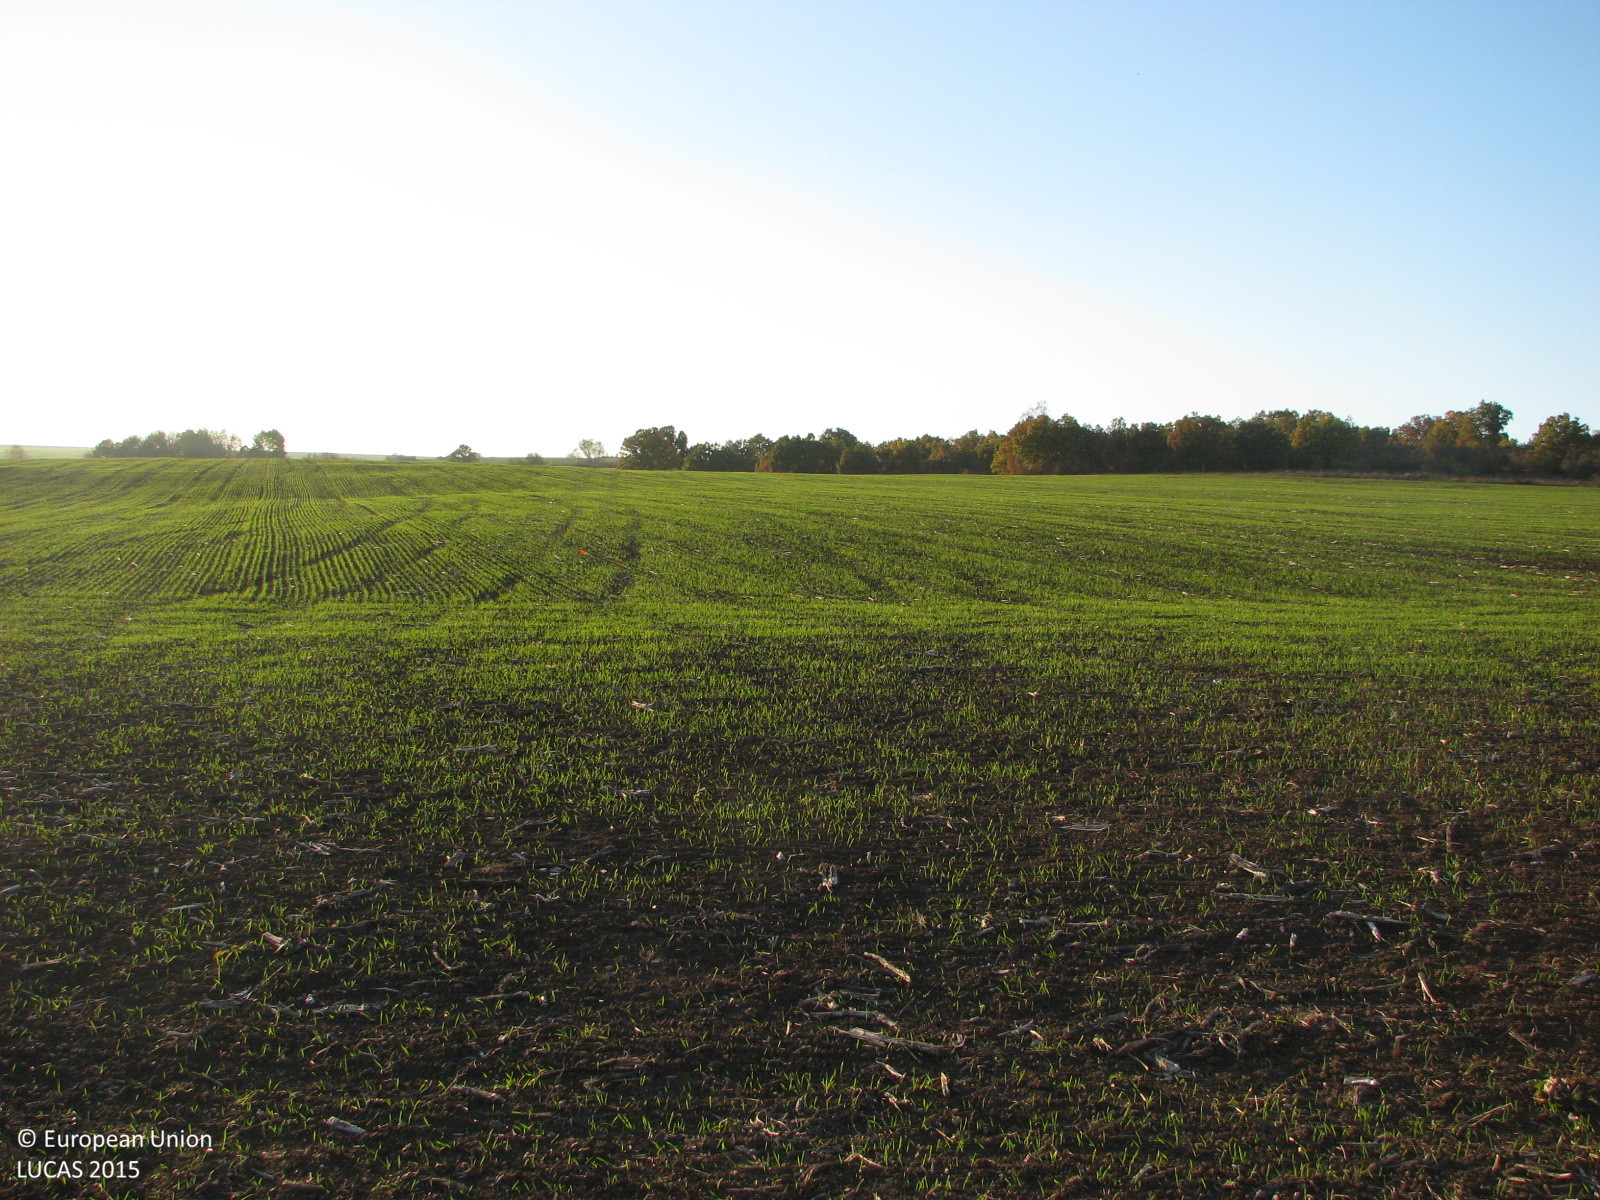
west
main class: Shrubland
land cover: Shrubland with sparse tree cover
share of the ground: 50 - 75 %
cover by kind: shrubs 70 %, herbaceous plants 25 %, broadleaved forest trees 5 %
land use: Semi-natural and natural areas not in use
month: November
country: BG
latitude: 42.0579
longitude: 26.8552
